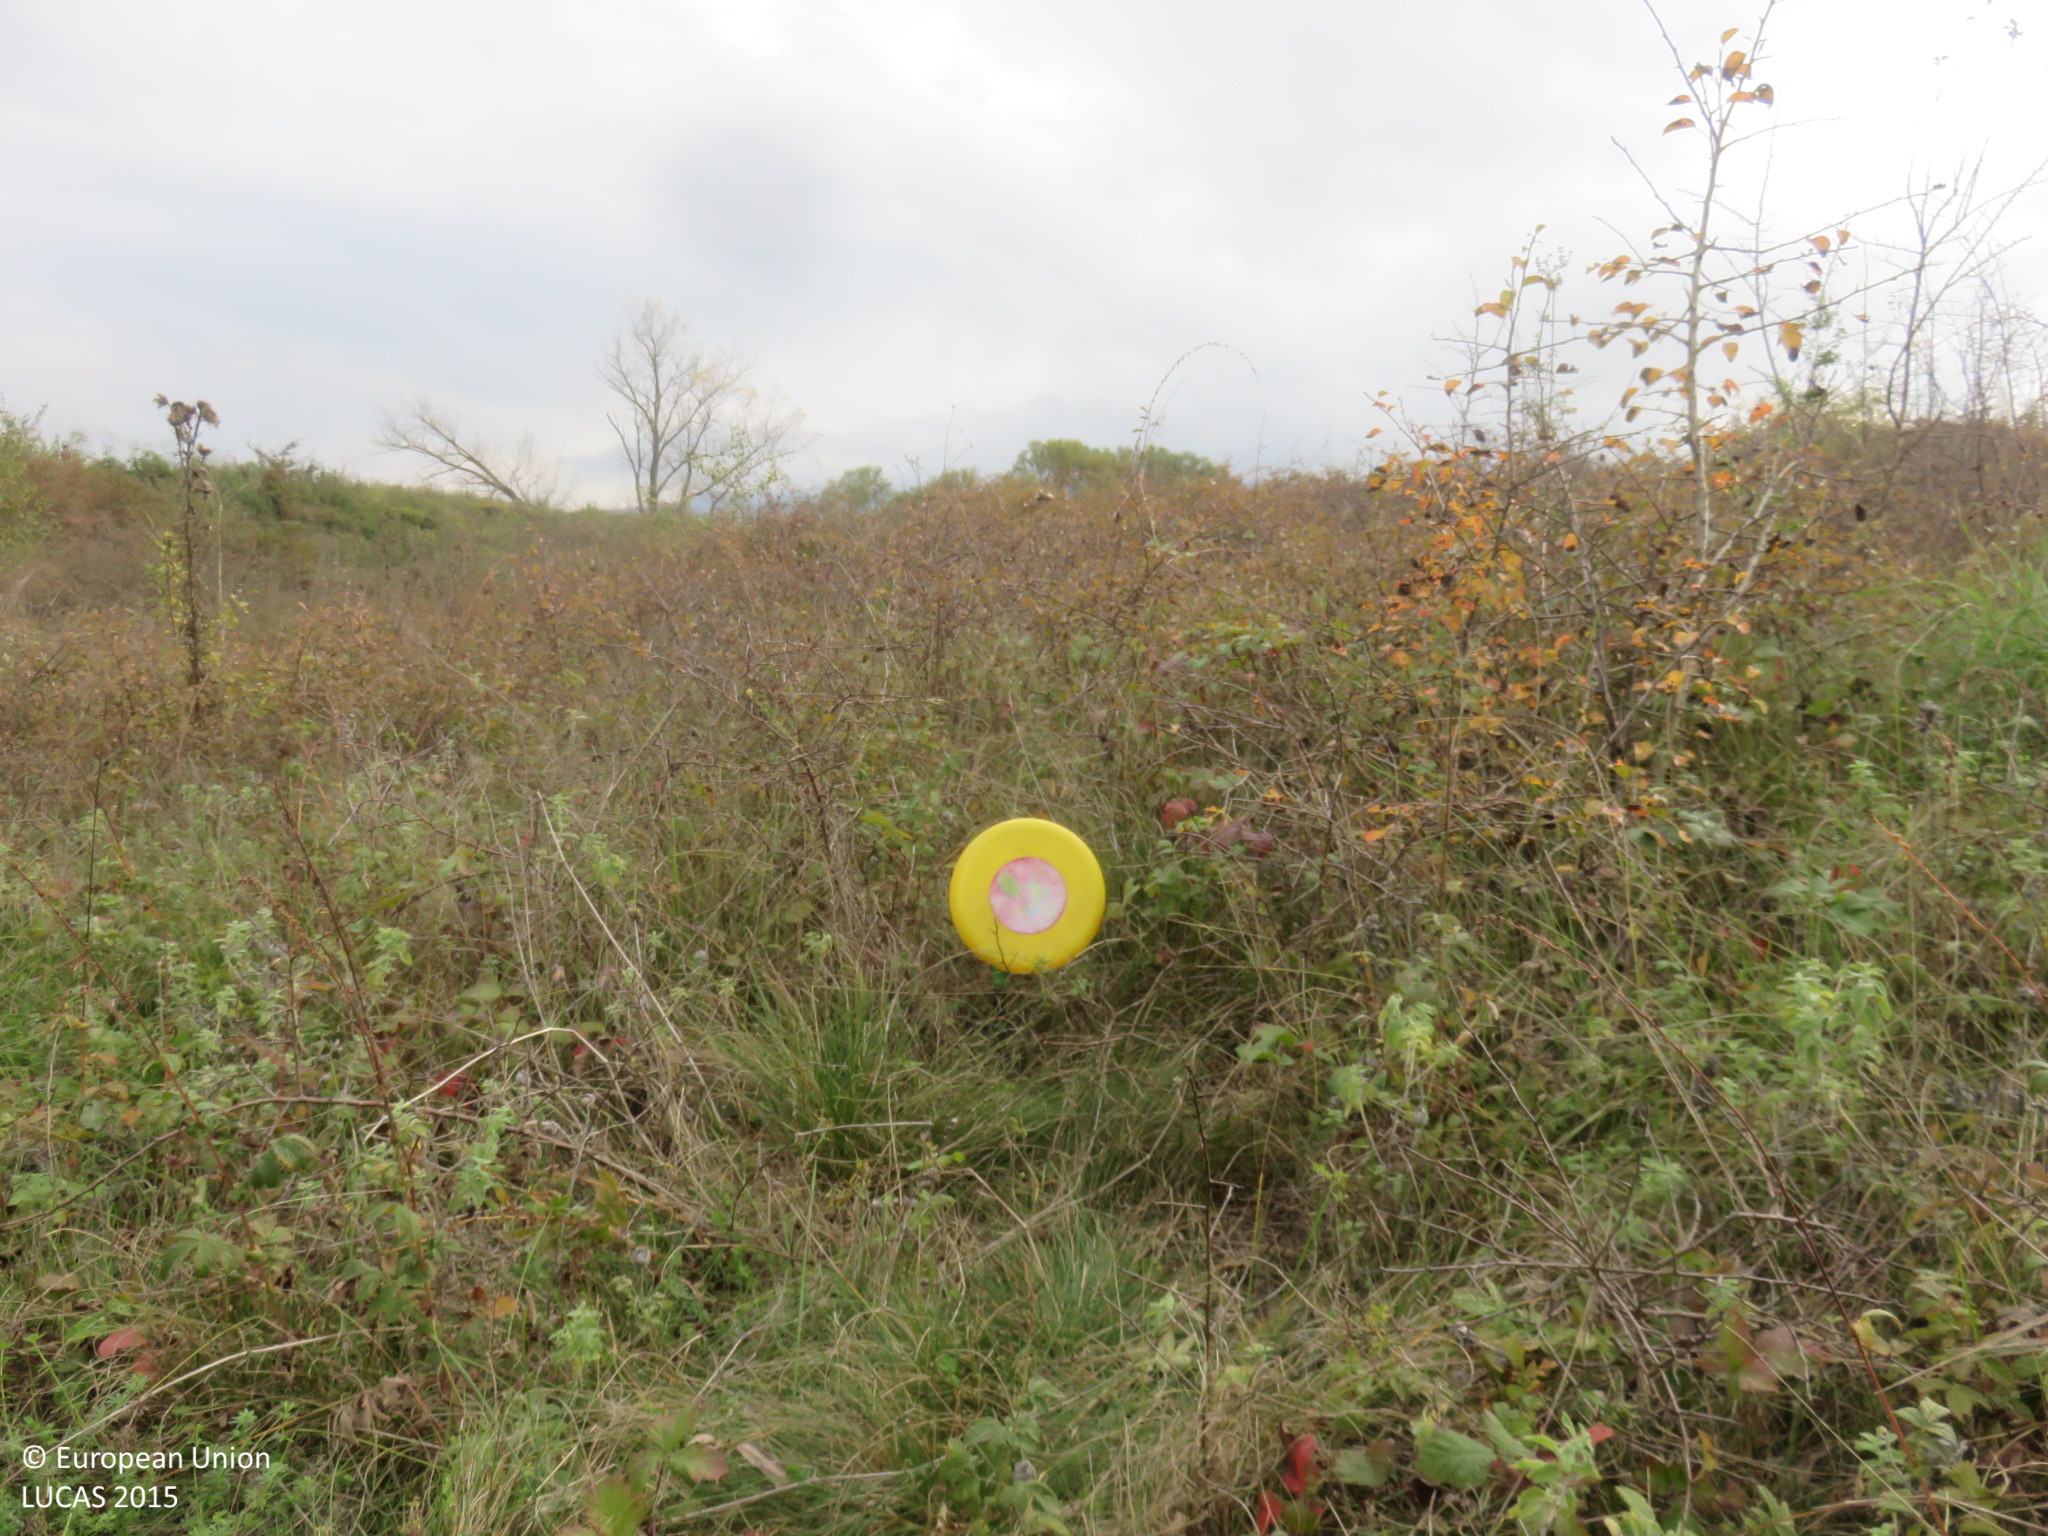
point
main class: Shrubland
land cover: Shrubland with sparse tree cover
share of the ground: > 75 %
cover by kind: shrubs 90 %, broadleaved forest trees 5 %, herbaceous plants 5 %
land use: Semi-natural and natural areas not in use
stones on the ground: < 10 %
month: October
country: BG
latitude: 42.9584
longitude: 25.0086
